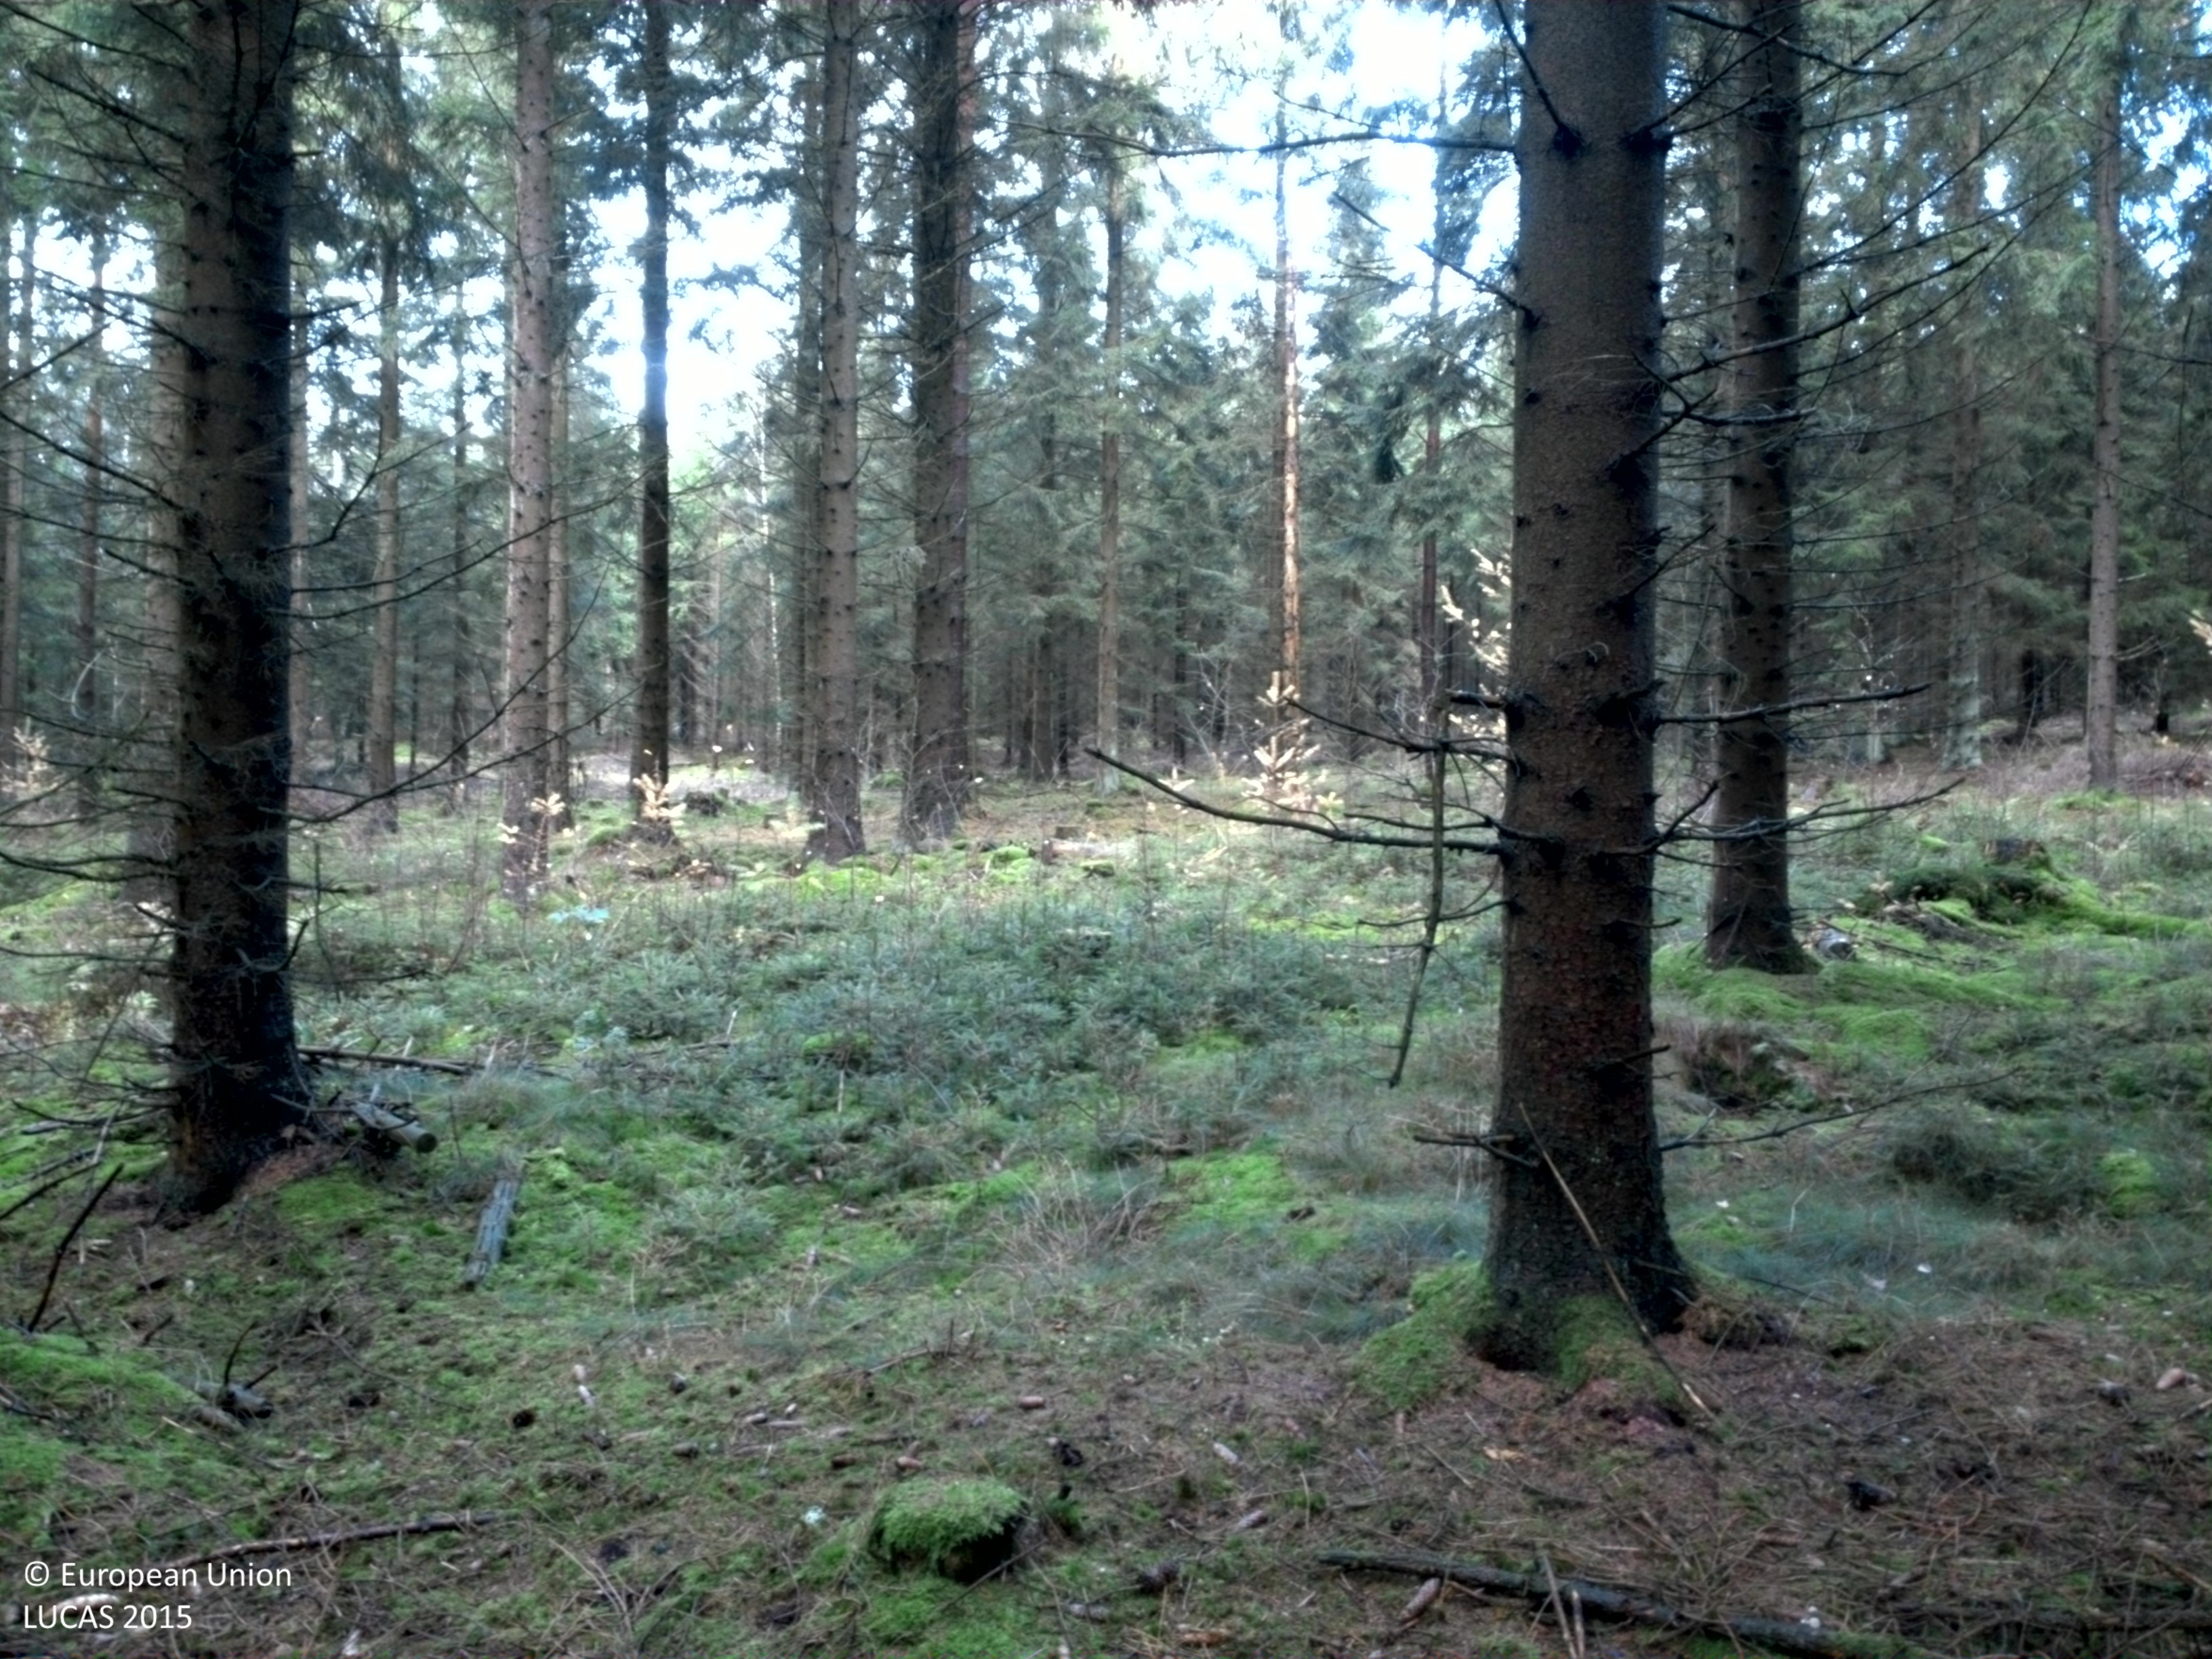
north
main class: Woodland
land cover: Spruce dominated coniferous woodland
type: hemiboreal forest and nemoral coniferous forest and mixed broadleaved-coniferous forest
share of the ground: > 75 %
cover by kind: coniferous forest trees 75 %, lichens and mosses 15 %, herbaceous plants 10 %
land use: Forestry
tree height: > 5 m
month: November
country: SE
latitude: 56.1487
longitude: 13.1685
